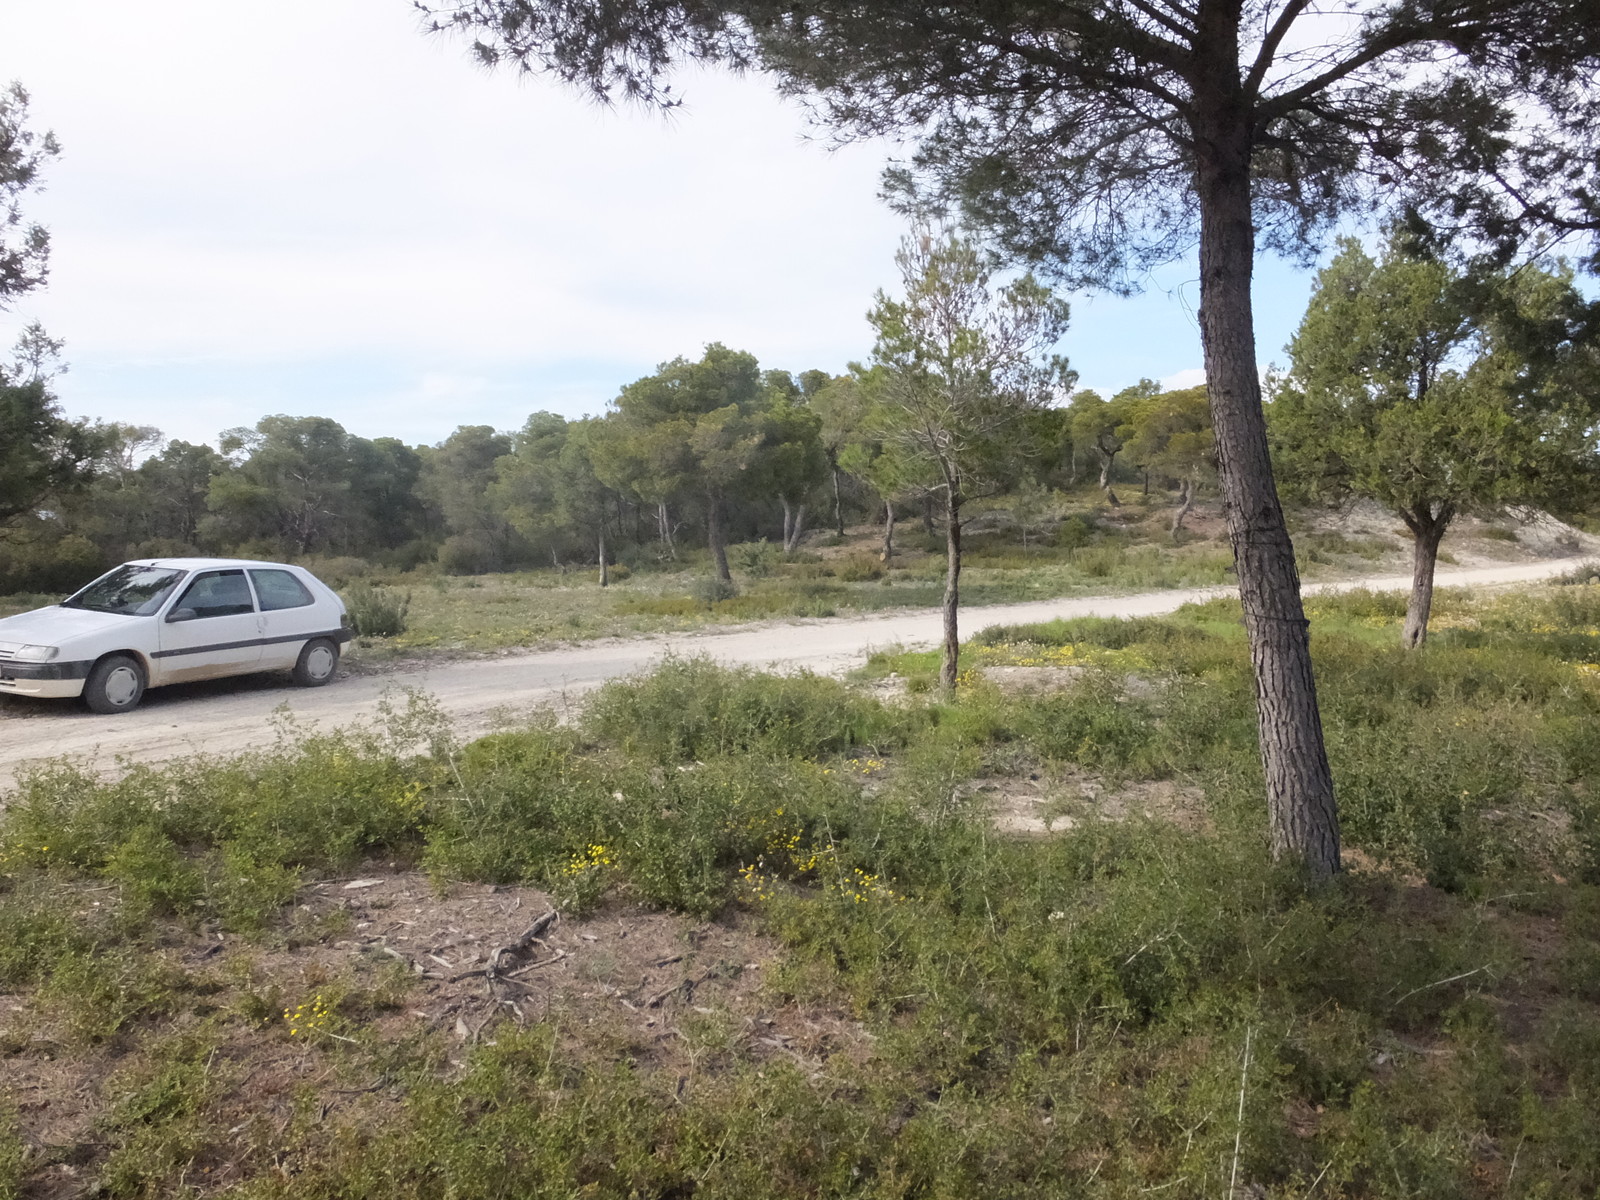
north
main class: Woodland
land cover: Pine dominated coniferous woodland
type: coniferous forest of the mediterranean region
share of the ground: 50 - 75 %
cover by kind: coniferous forest trees 70 %, broadleaved forest trees 15 %, shrubs 10 %, herbaceous plants 5 %
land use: Forestry
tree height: > 5 m
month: April
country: ES
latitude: 41.6153
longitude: -0.3262
